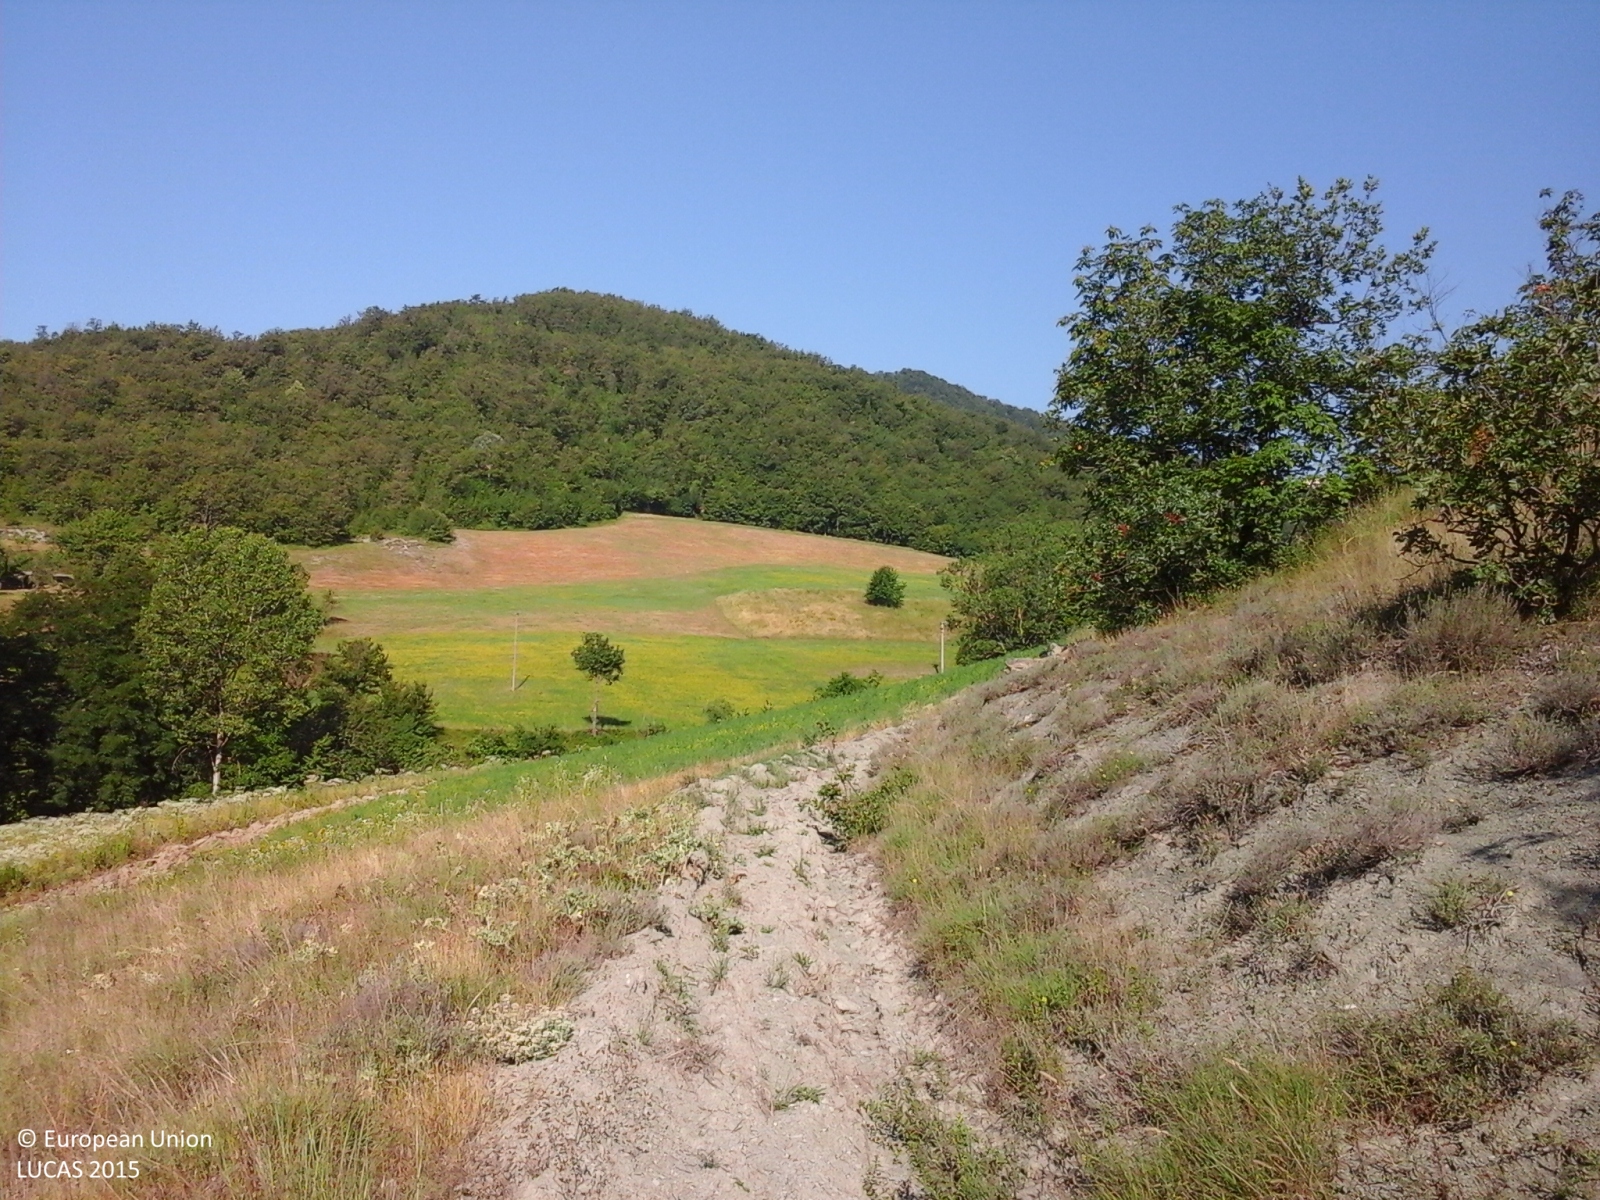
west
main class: Shrubland
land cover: Shrubland with sparse tree cover
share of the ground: > 75 %
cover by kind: herbaceous plants 50 %, consolidated bare surface 25 %, shrubs 20 %, broadleaved forest trees 5 %
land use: Semi-natural and natural areas not in use
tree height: < 5 m
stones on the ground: > 50 %
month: June
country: IT
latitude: 44.5716
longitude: 8.3287
